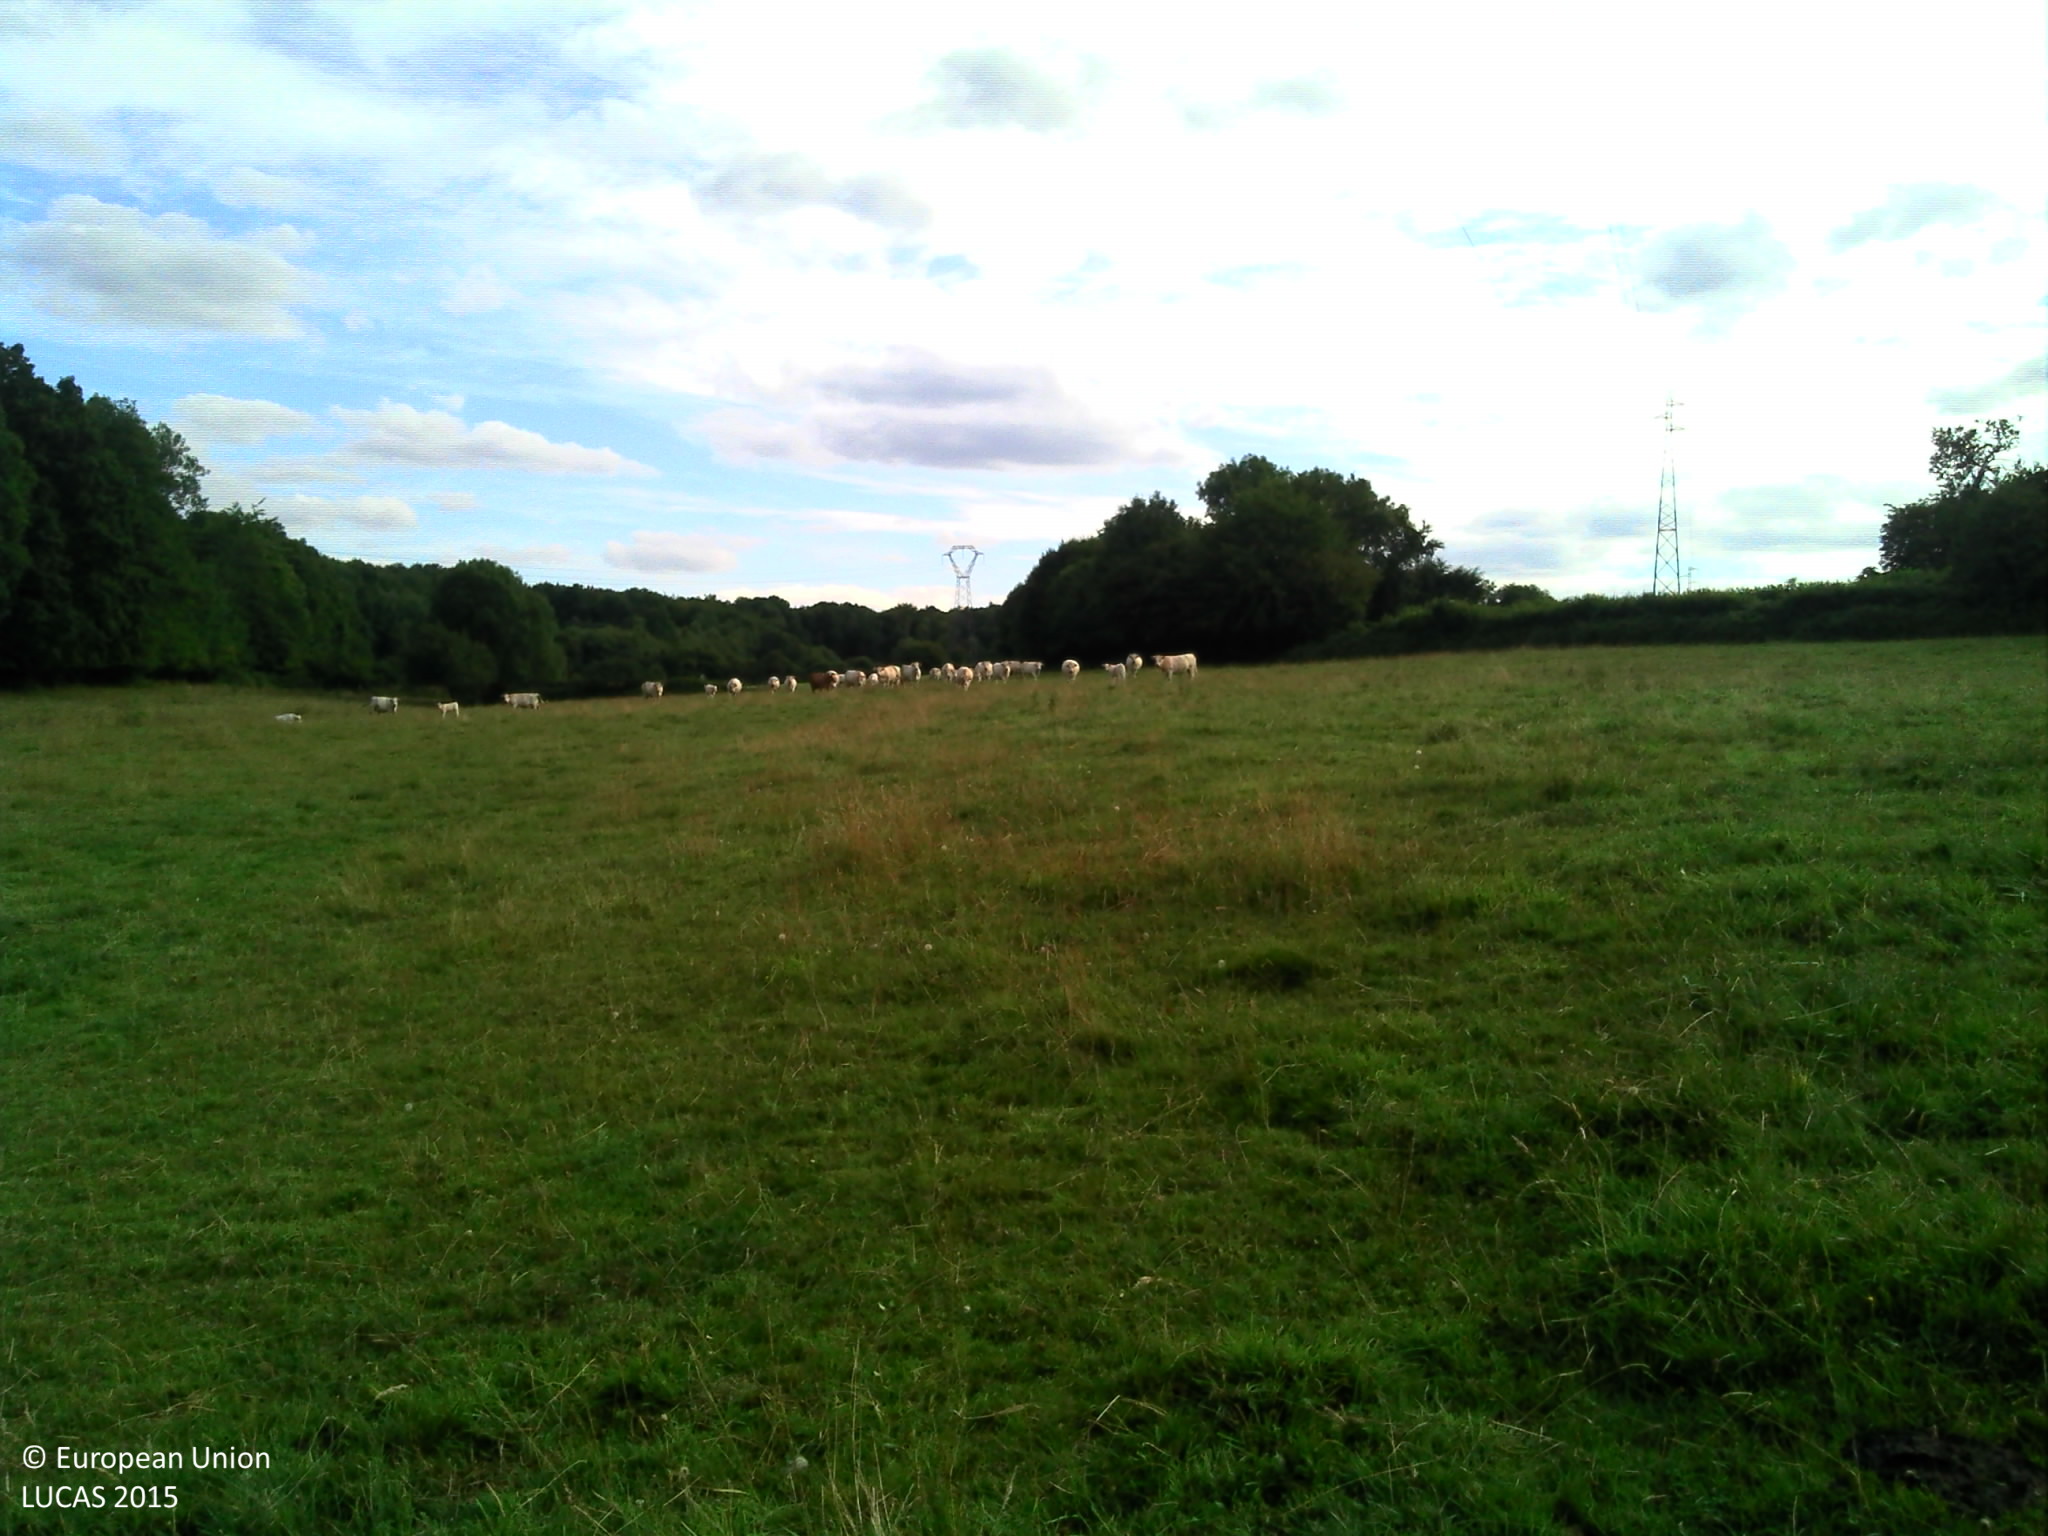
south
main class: Grassland
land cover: Grassland without tree/shrub cover
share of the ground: > 75 %
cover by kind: herbaceous plants 100 %
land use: Agriculture (excluding fallow land and kitchen gardens)
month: July
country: FR
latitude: 48.7005
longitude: 0.5043
